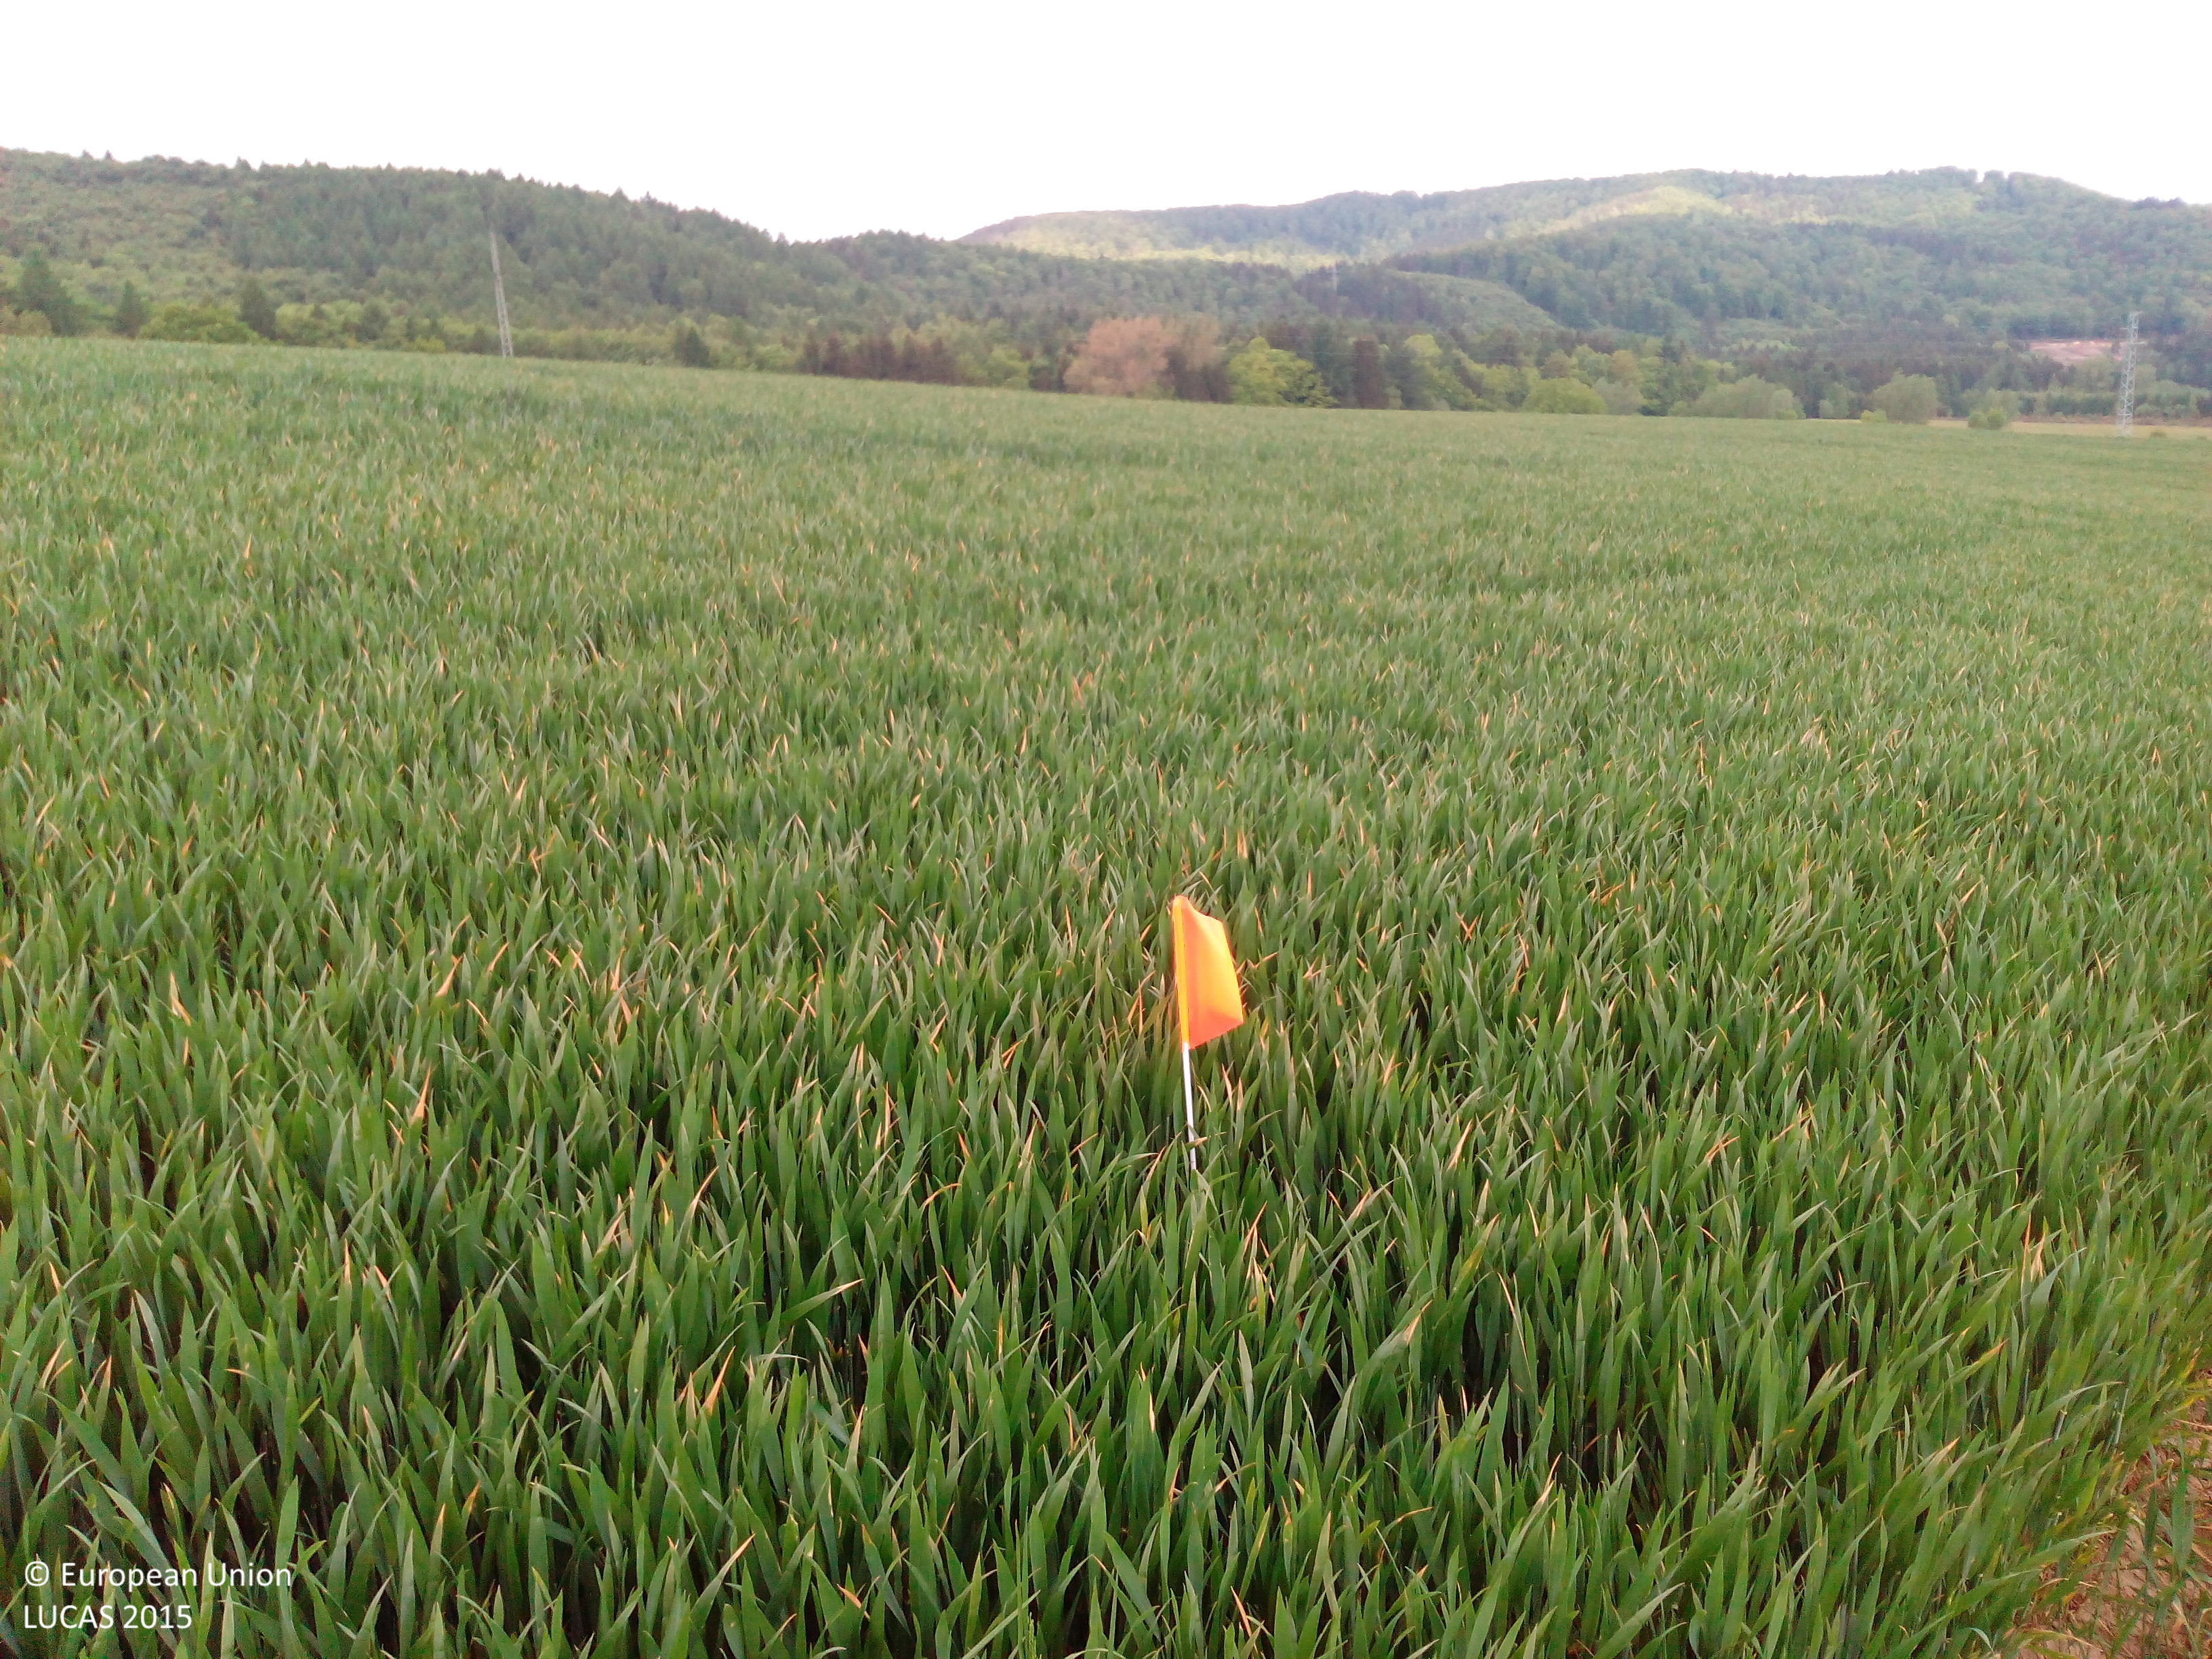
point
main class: Cropland
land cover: Barley
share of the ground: > 75 %
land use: Agriculture (excluding fallow land and kitchen gardens)
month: May
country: DE
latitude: 51.9095
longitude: 9.6076
